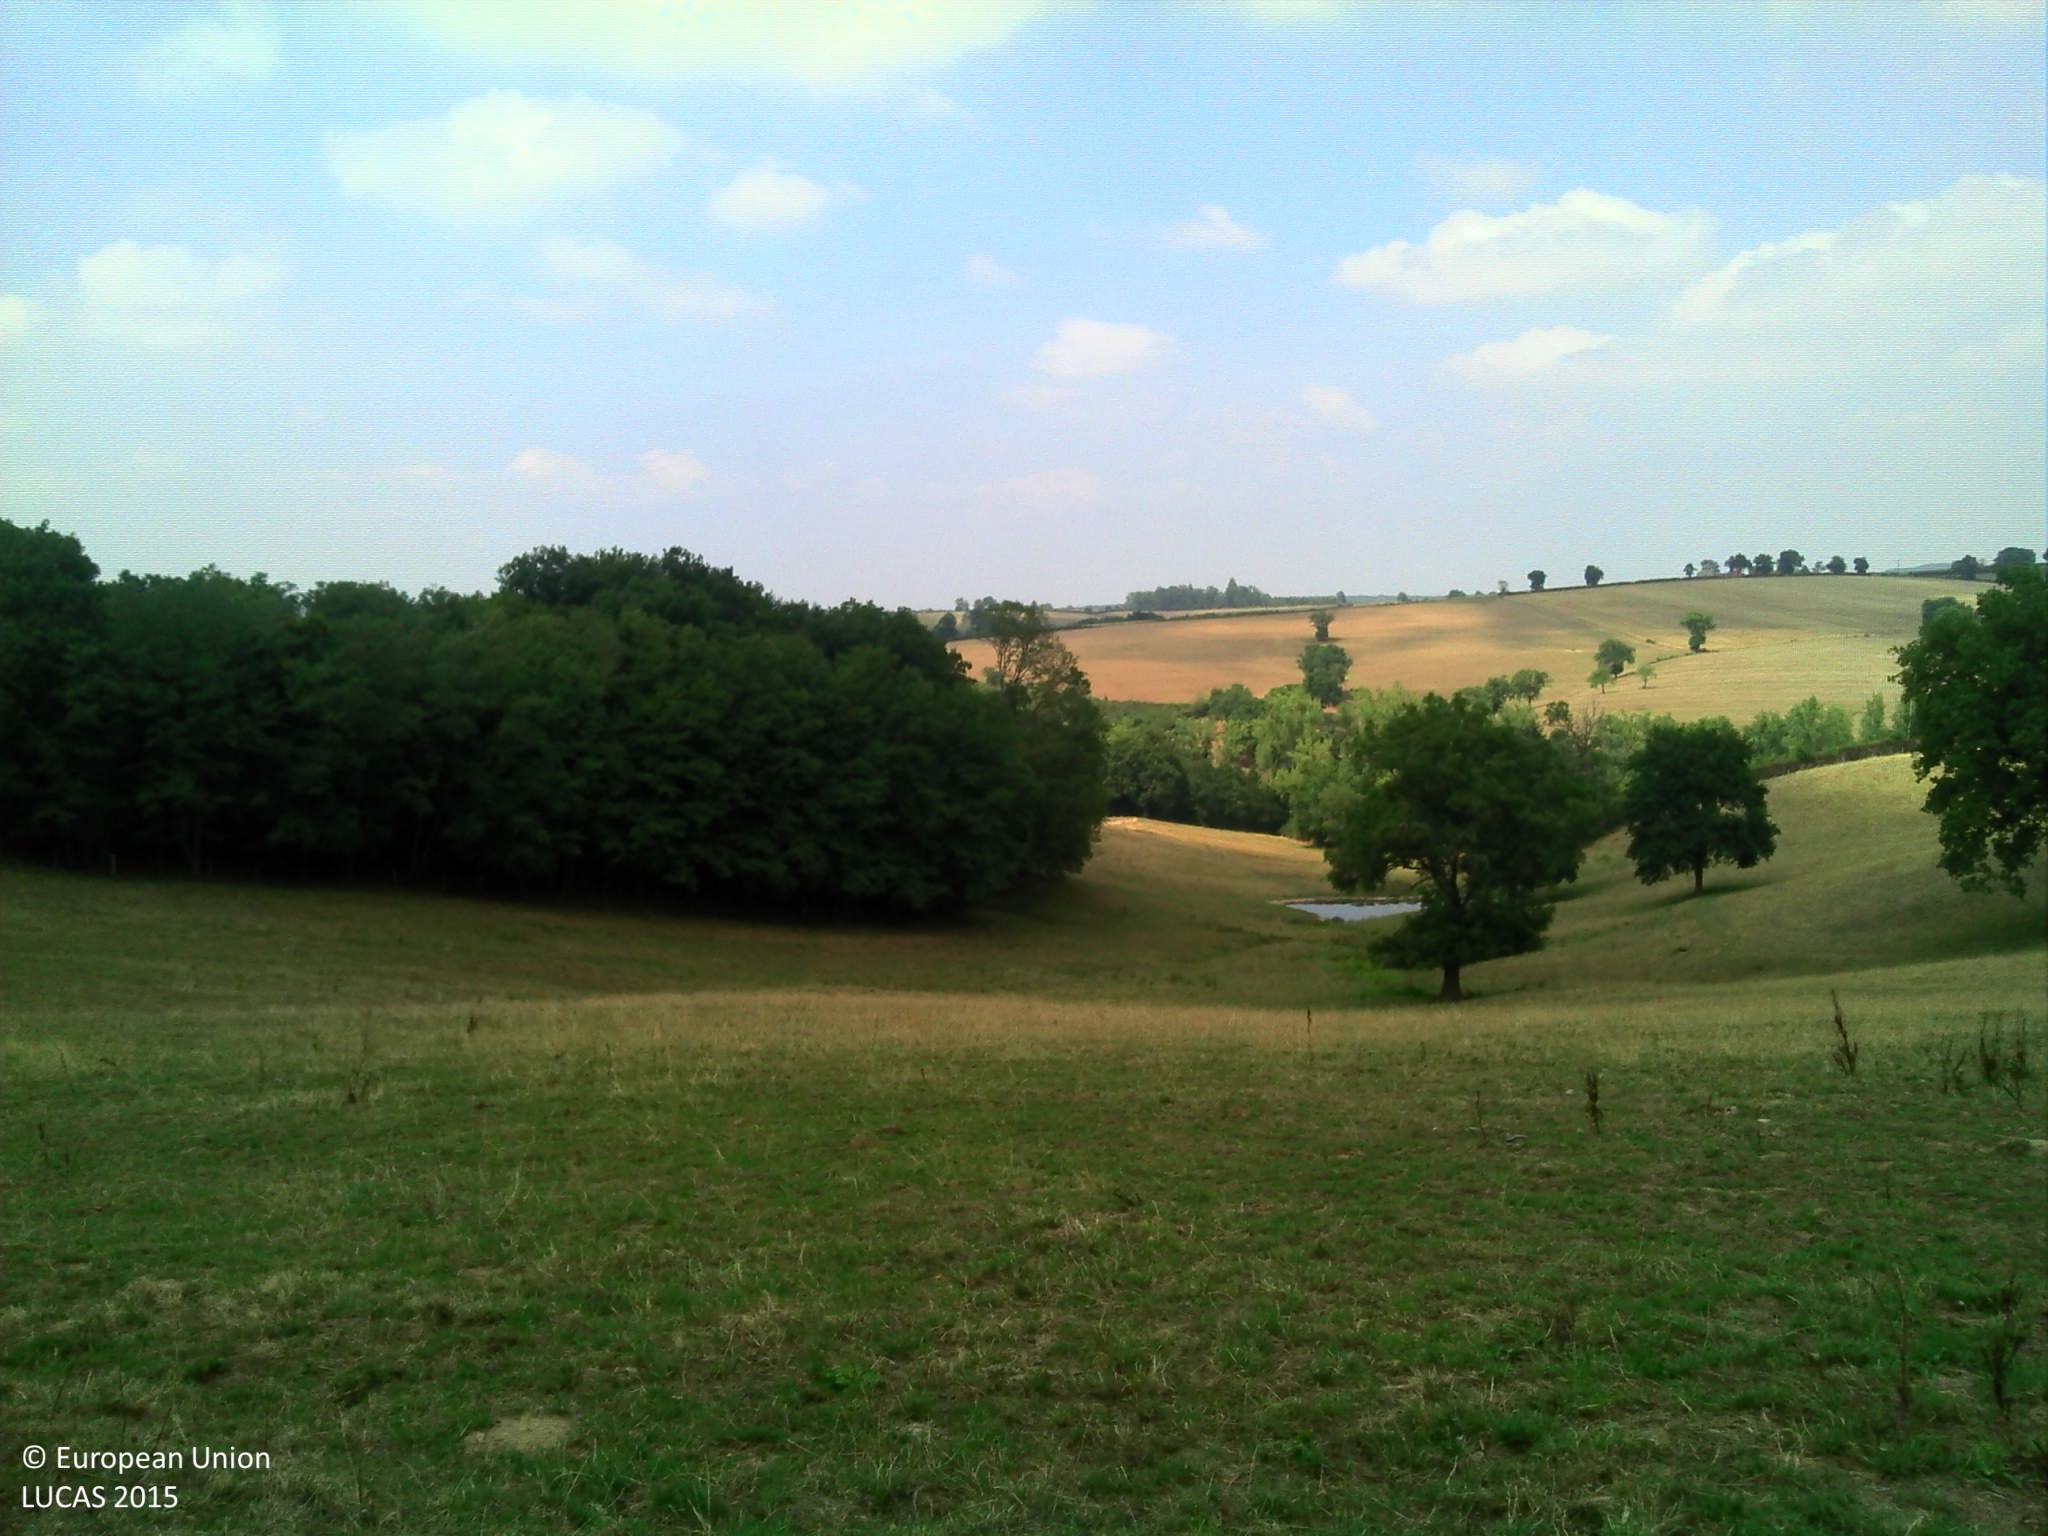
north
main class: Grassland
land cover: Grassland without tree/shrub cover
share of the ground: > 75 %
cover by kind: herbaceous plants 100 %
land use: Agriculture (excluding fallow land and kitchen gardens)
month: August
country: FR
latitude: 46.3445
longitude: 3.6721
